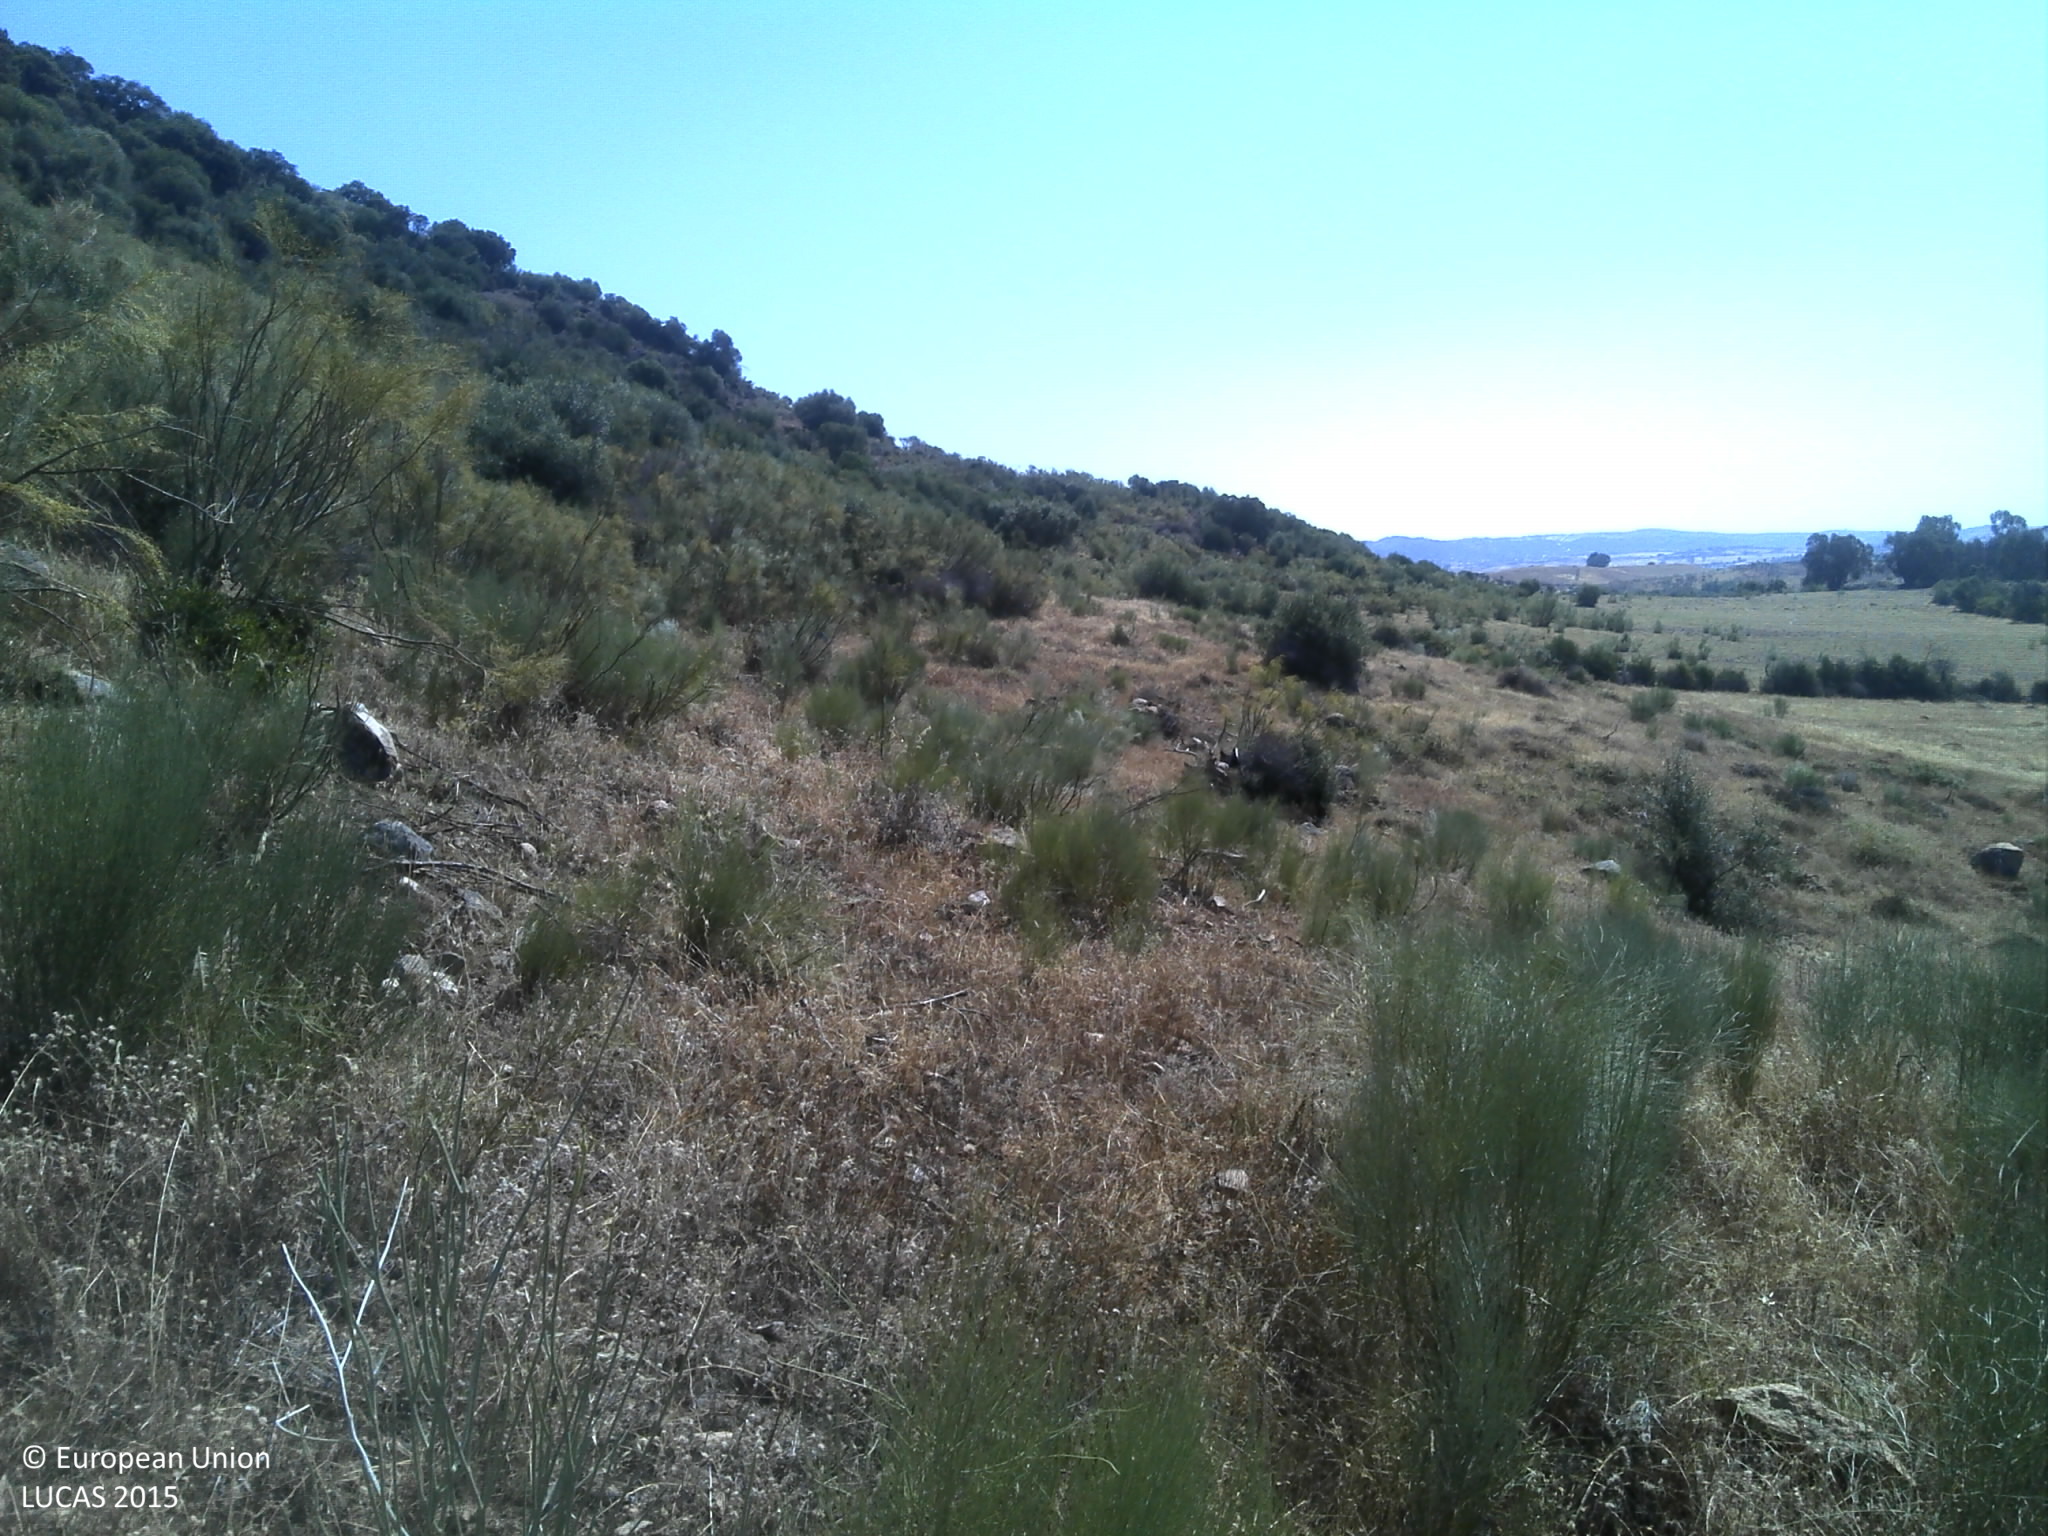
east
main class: Shrubland
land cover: Shrubland with sparse tree cover
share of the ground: 25 - 50 %
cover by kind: shrubs 30 %, herbaceous plants 30 %, unconsolidated bare surface 30 %, broadleaved forest trees 5 %
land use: Agriculture (excluding fallow land and kitchen gardens)
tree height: < 5 m
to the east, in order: Shrubland with sparse tree cover; Grassland with sparse tree/shrub cover; Shruby margins; Fences; Shruby margins; Grassland with sparse tree/shrub cover
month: June
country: PT
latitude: 39.9022
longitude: -7.2776
